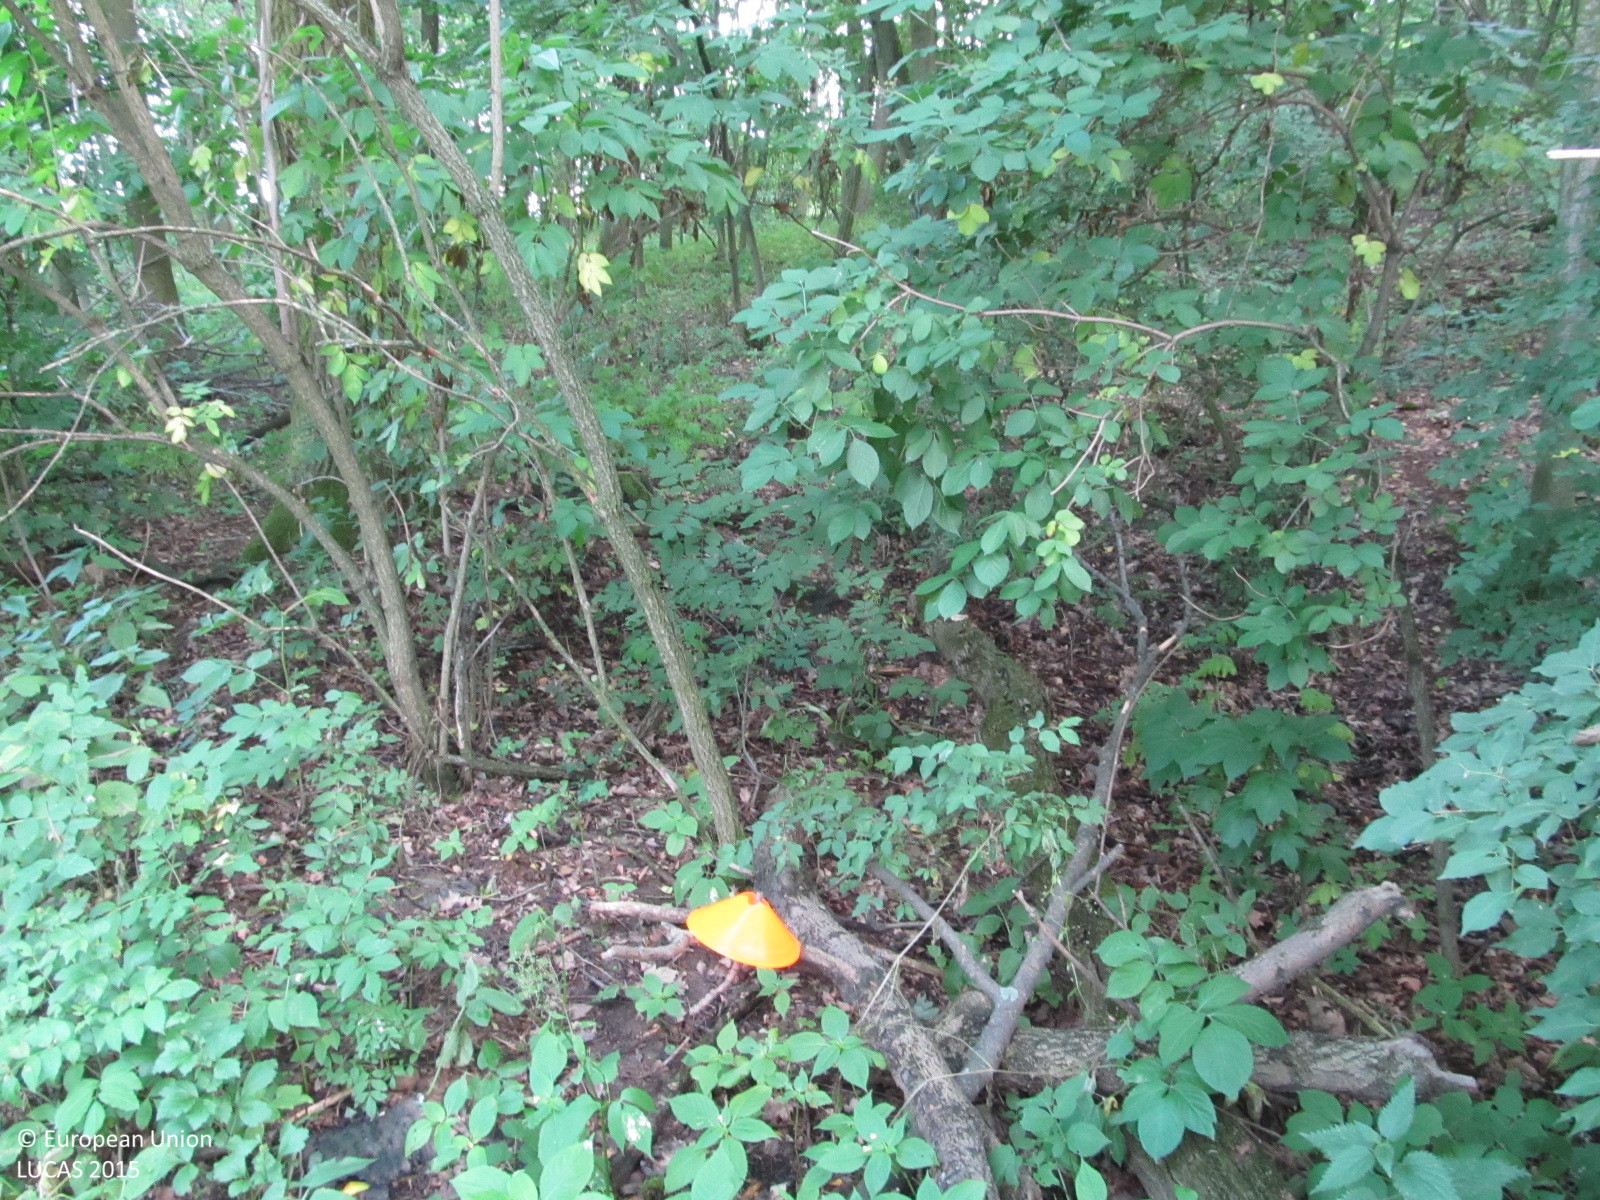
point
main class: Woodland
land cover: Broadleaved woodland
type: hemiboreal forest and nemoral coniferous forest and mixed broadleaved-coniferous forest
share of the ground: > 75 %
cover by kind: broadleaved forest trees 80 %, shrubs 10 %, herbaceous plants 10 %
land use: Forestry
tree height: > 5 m
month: June
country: AT
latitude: 48.5571
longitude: 15.8162
